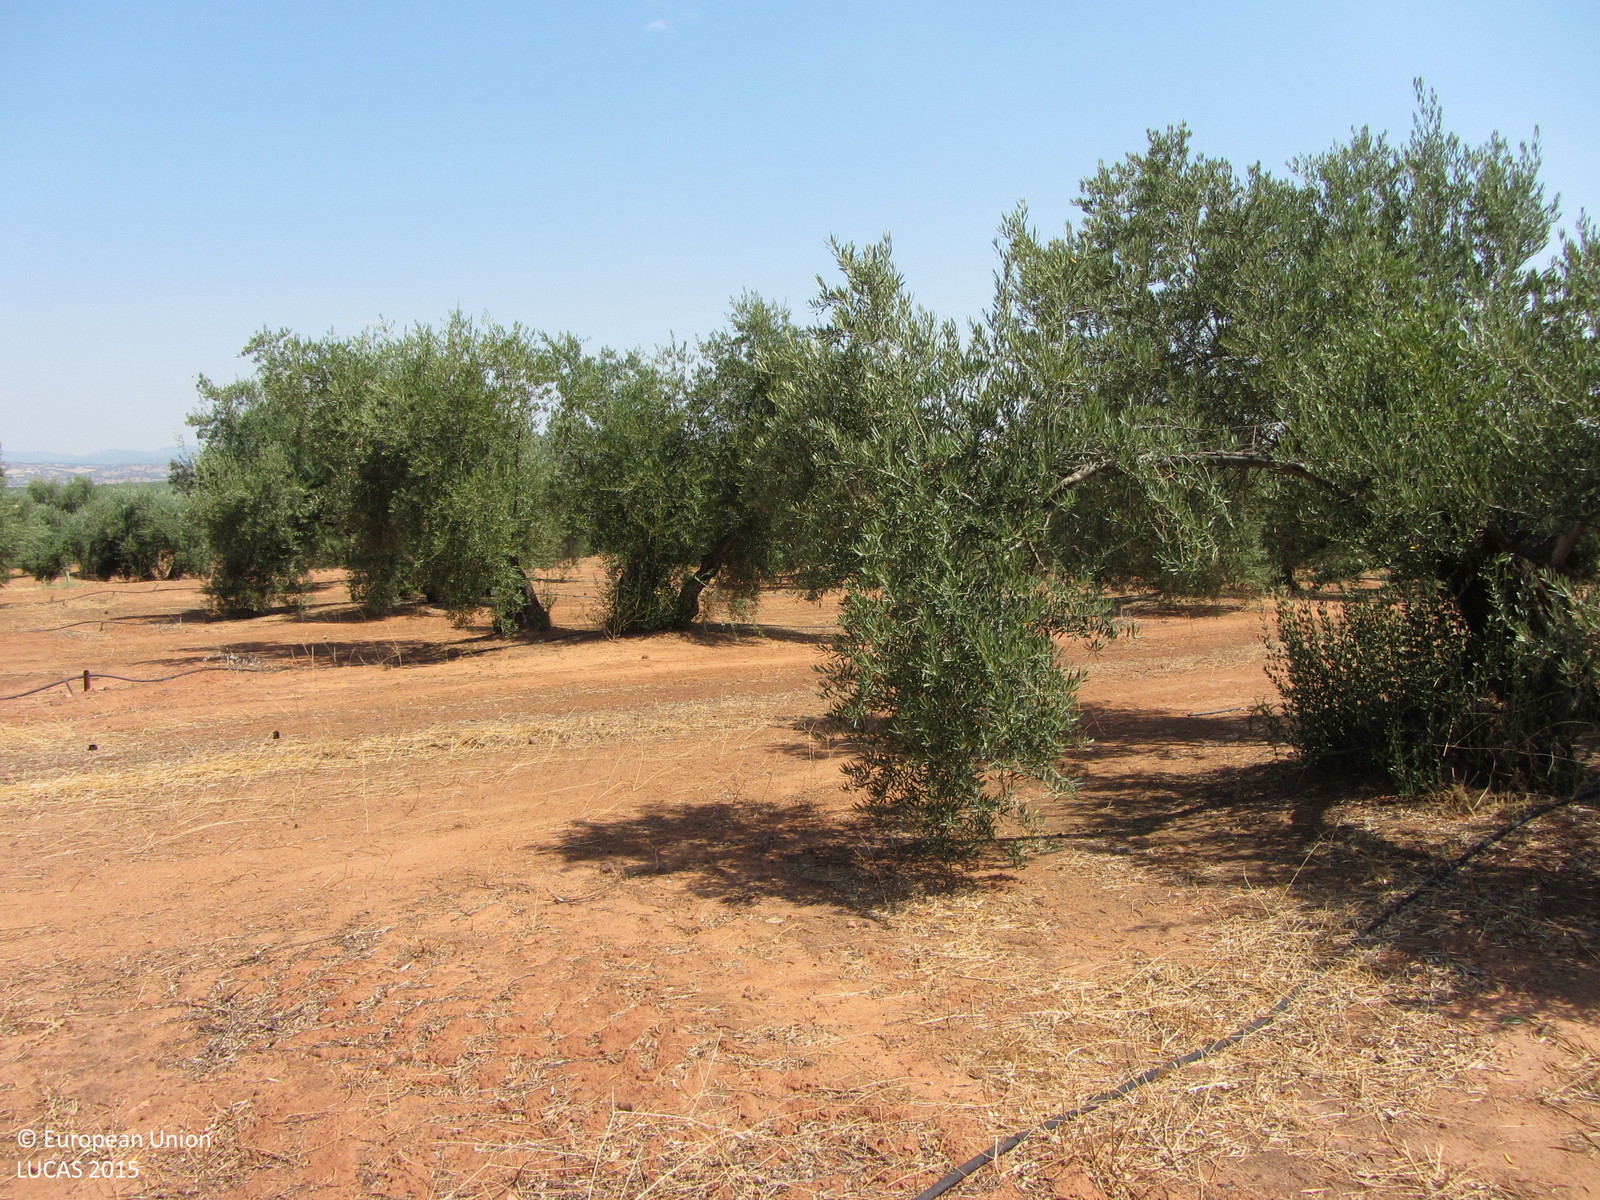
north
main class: Cropland
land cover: Olive groves
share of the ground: 25 - 50 %
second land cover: Other bare soil
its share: > 75 %
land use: Agriculture (excluding fallow land and kitchen gardens)
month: June
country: ES
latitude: 38.2074
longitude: -3.3991
